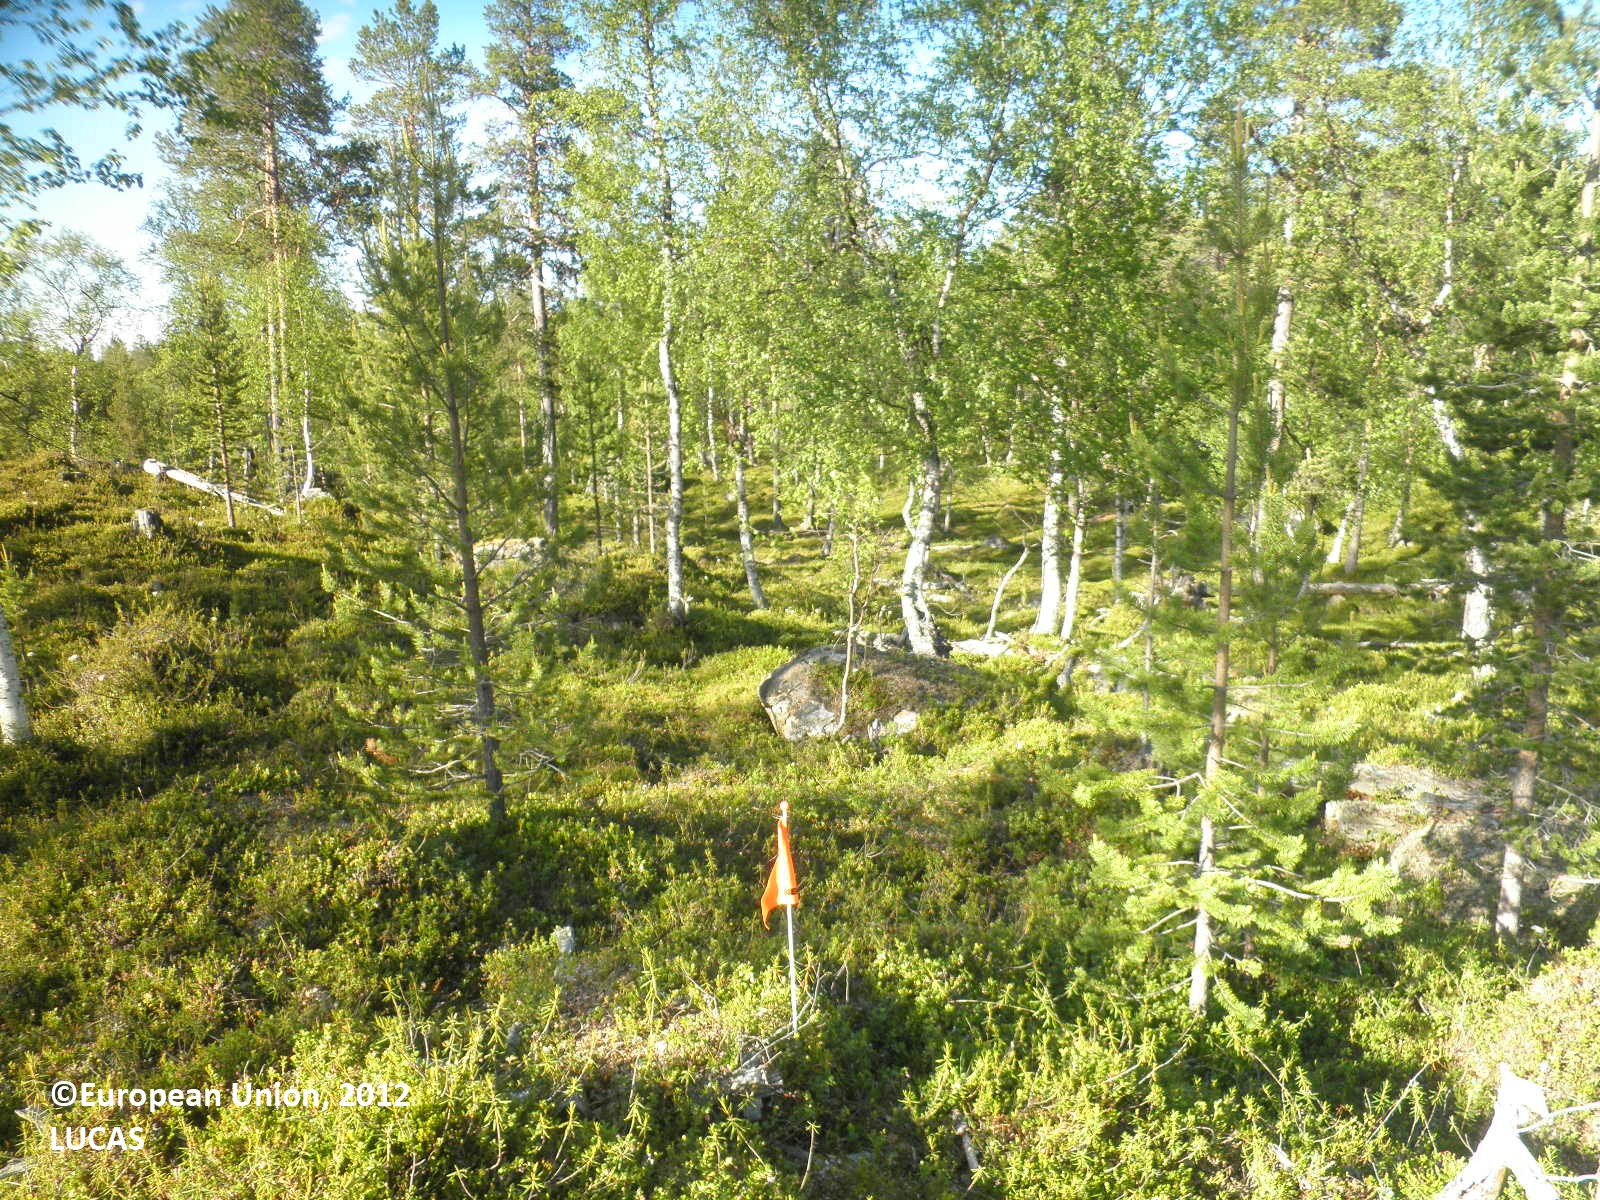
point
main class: Woodland
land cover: Pine dominated mixed woodland
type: boreal forest
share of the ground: 25 - 50 %
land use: Forestry
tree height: > 5 m
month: July
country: FI
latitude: 68.8534
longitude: 27.2295
